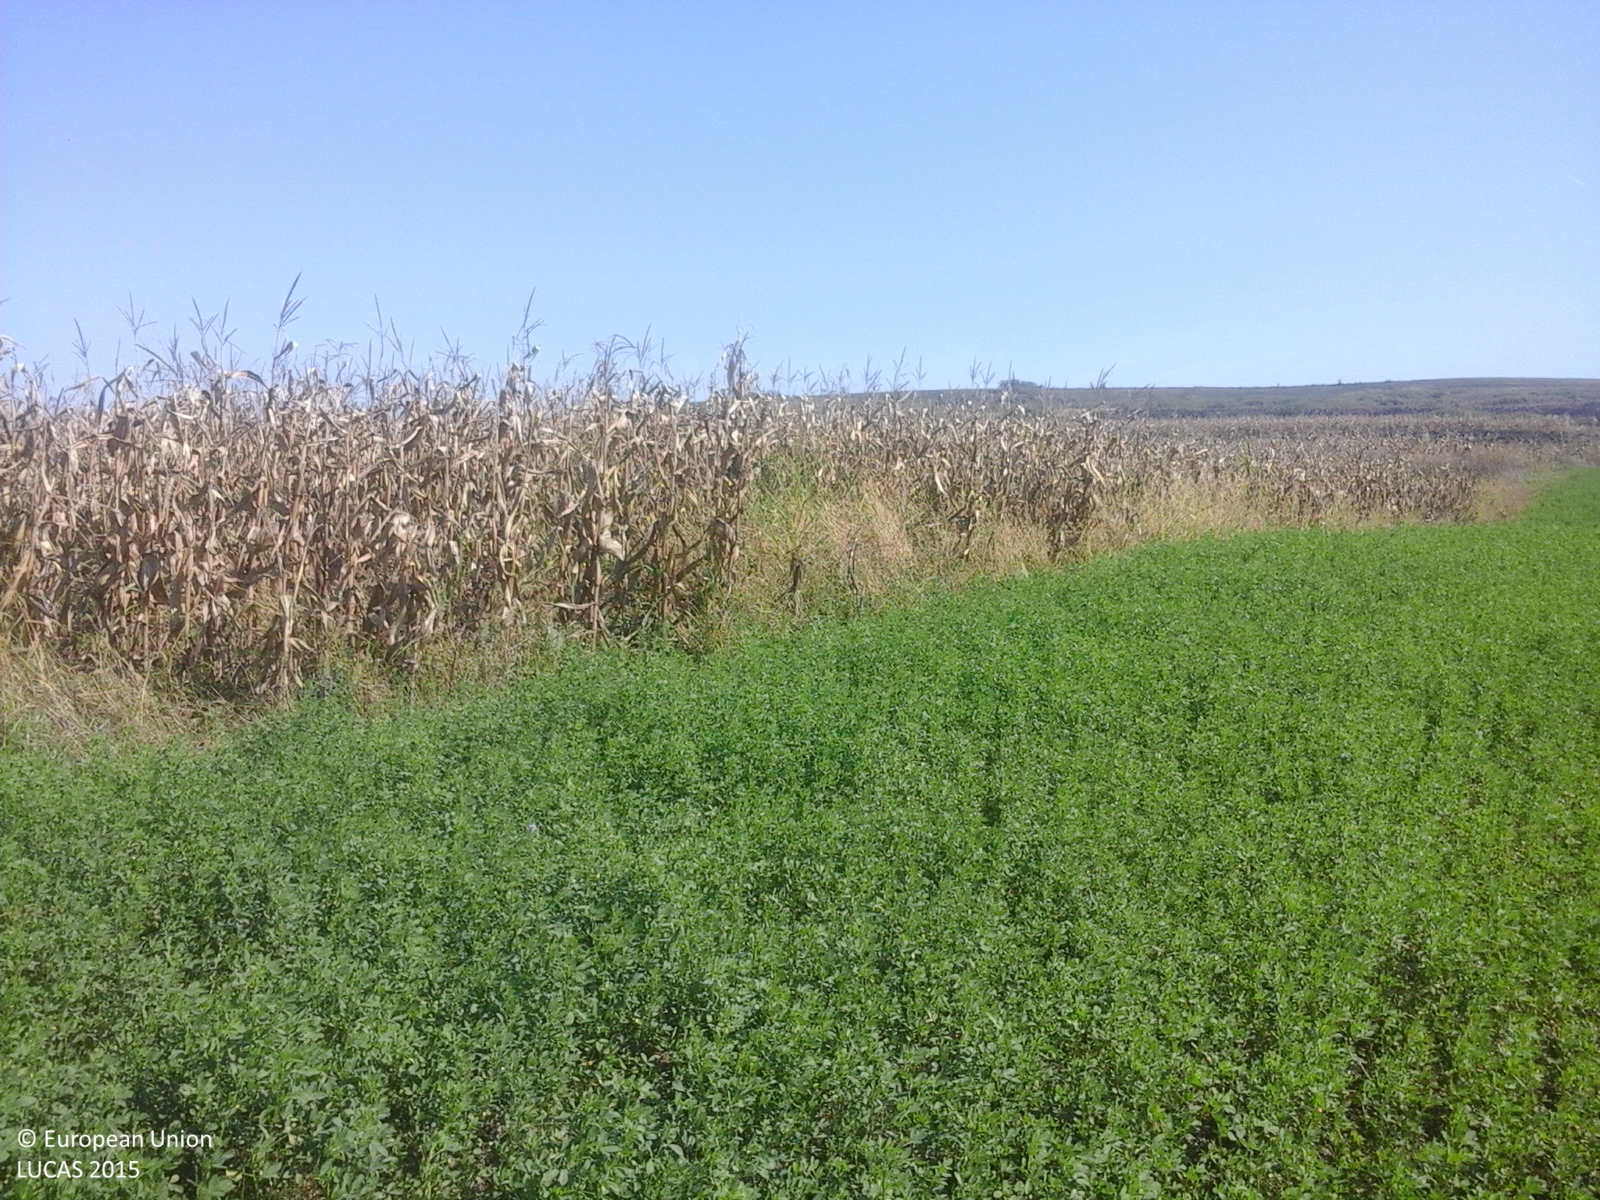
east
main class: Cropland
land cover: Lucerne
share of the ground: > 75 %
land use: Agriculture (excluding fallow land and kitchen gardens)
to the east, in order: Lucerne; Maize; Grassland without tree/shrub cover; Maize; Grassland with sparse tree/shrub cover; Other bare soil
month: October
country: RO
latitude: 46.2429
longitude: 23.7532
